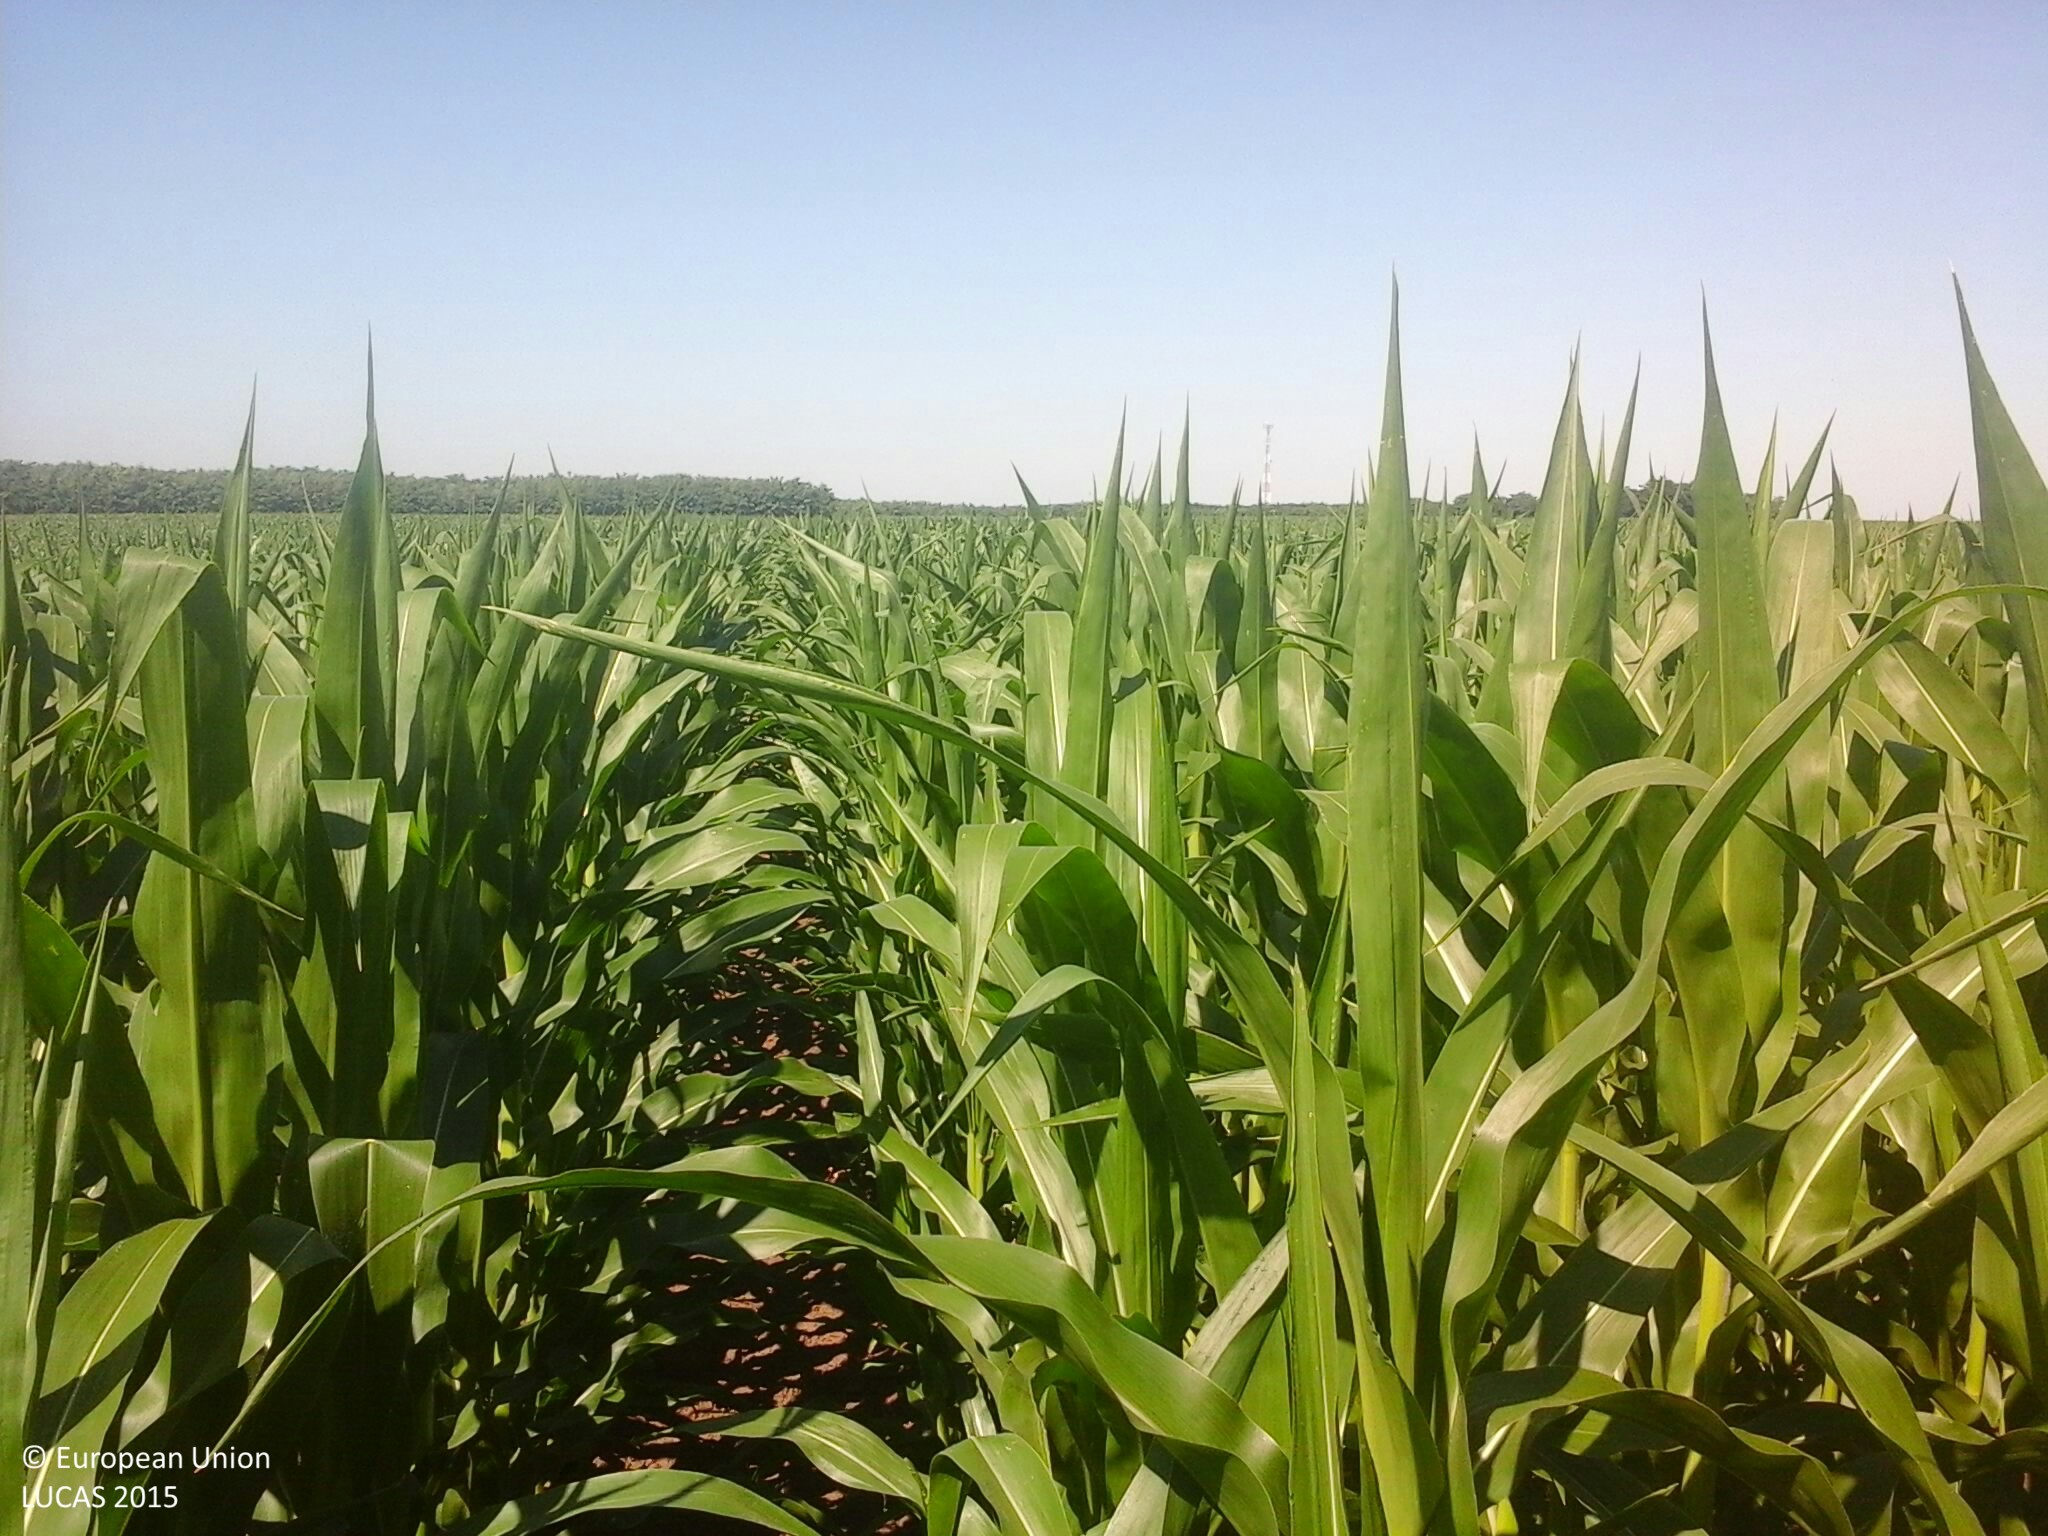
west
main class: Cropland
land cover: Maize
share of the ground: 50 - 75 %
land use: Agriculture (excluding fallow land and kitchen gardens)
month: July
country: HU
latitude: 47.8607
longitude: 21.9606
